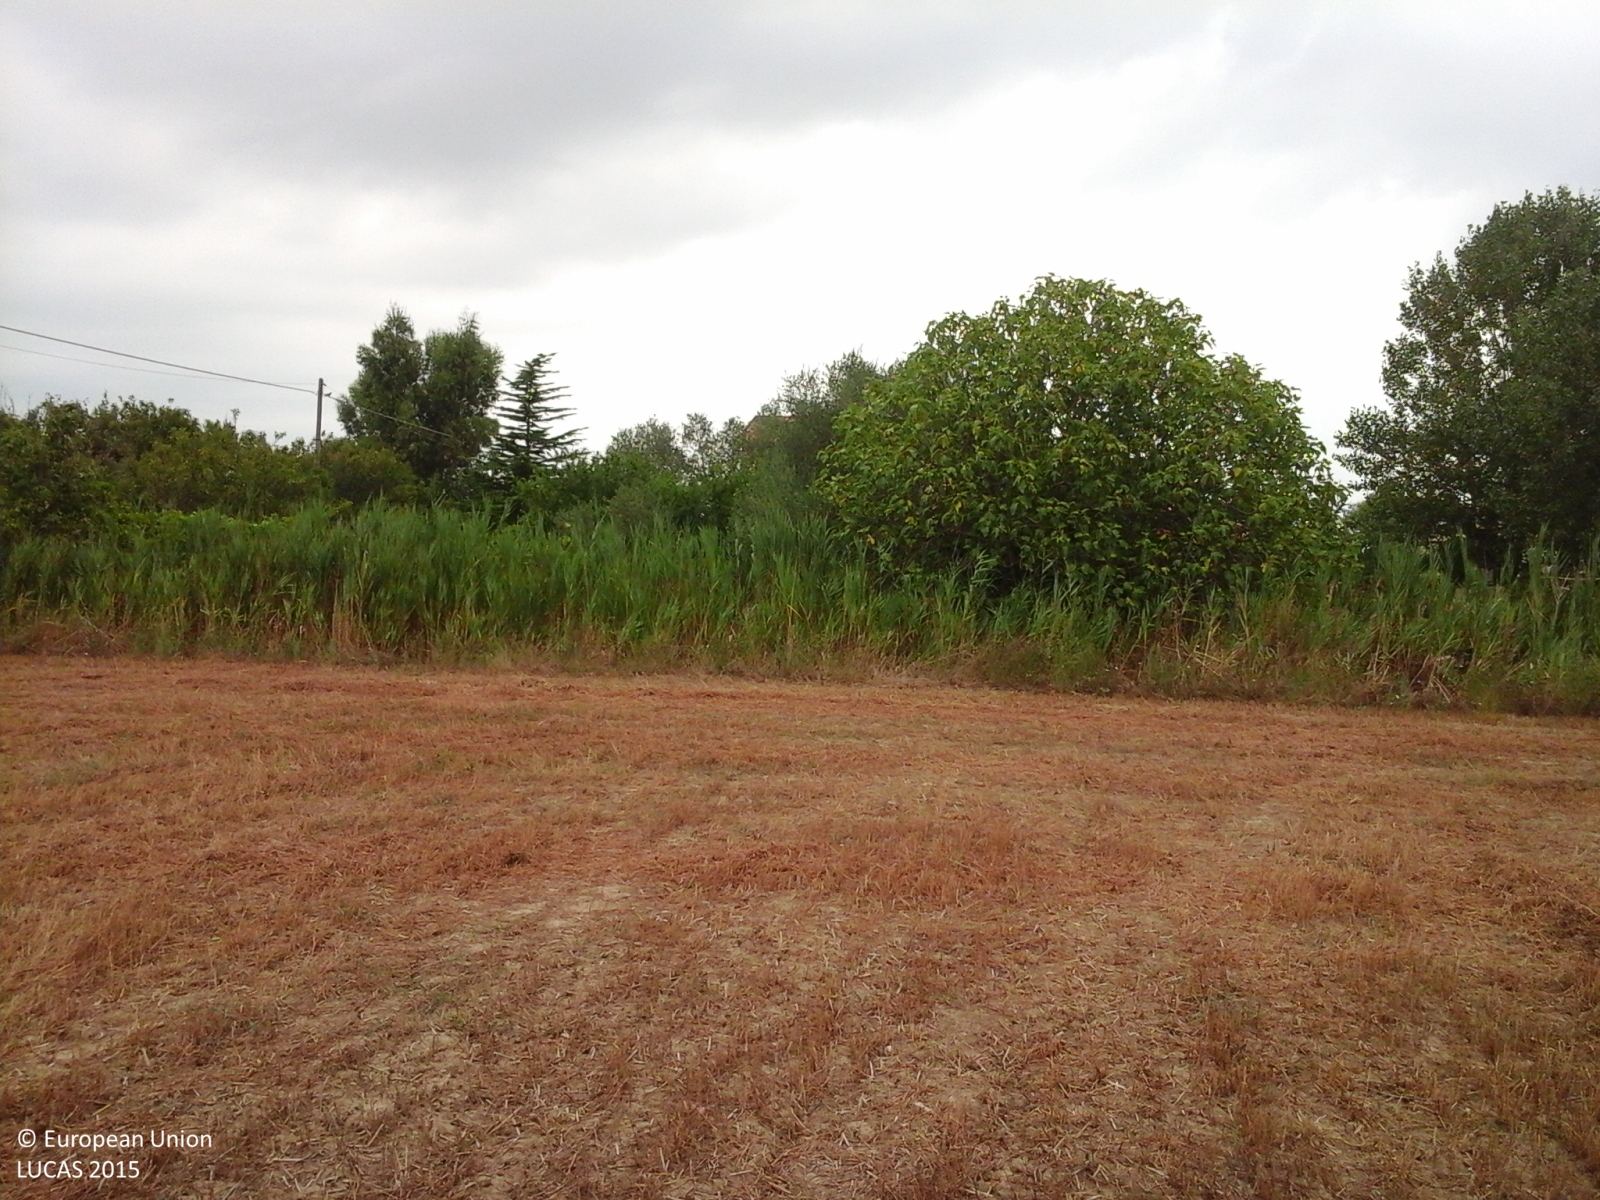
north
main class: Cropland
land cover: Clovers
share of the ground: > 75 %
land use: Agriculture (excluding fallow land and kitchen gardens)
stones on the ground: < 10 %
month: August
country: IT
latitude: 42.8474
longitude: 11.0367
